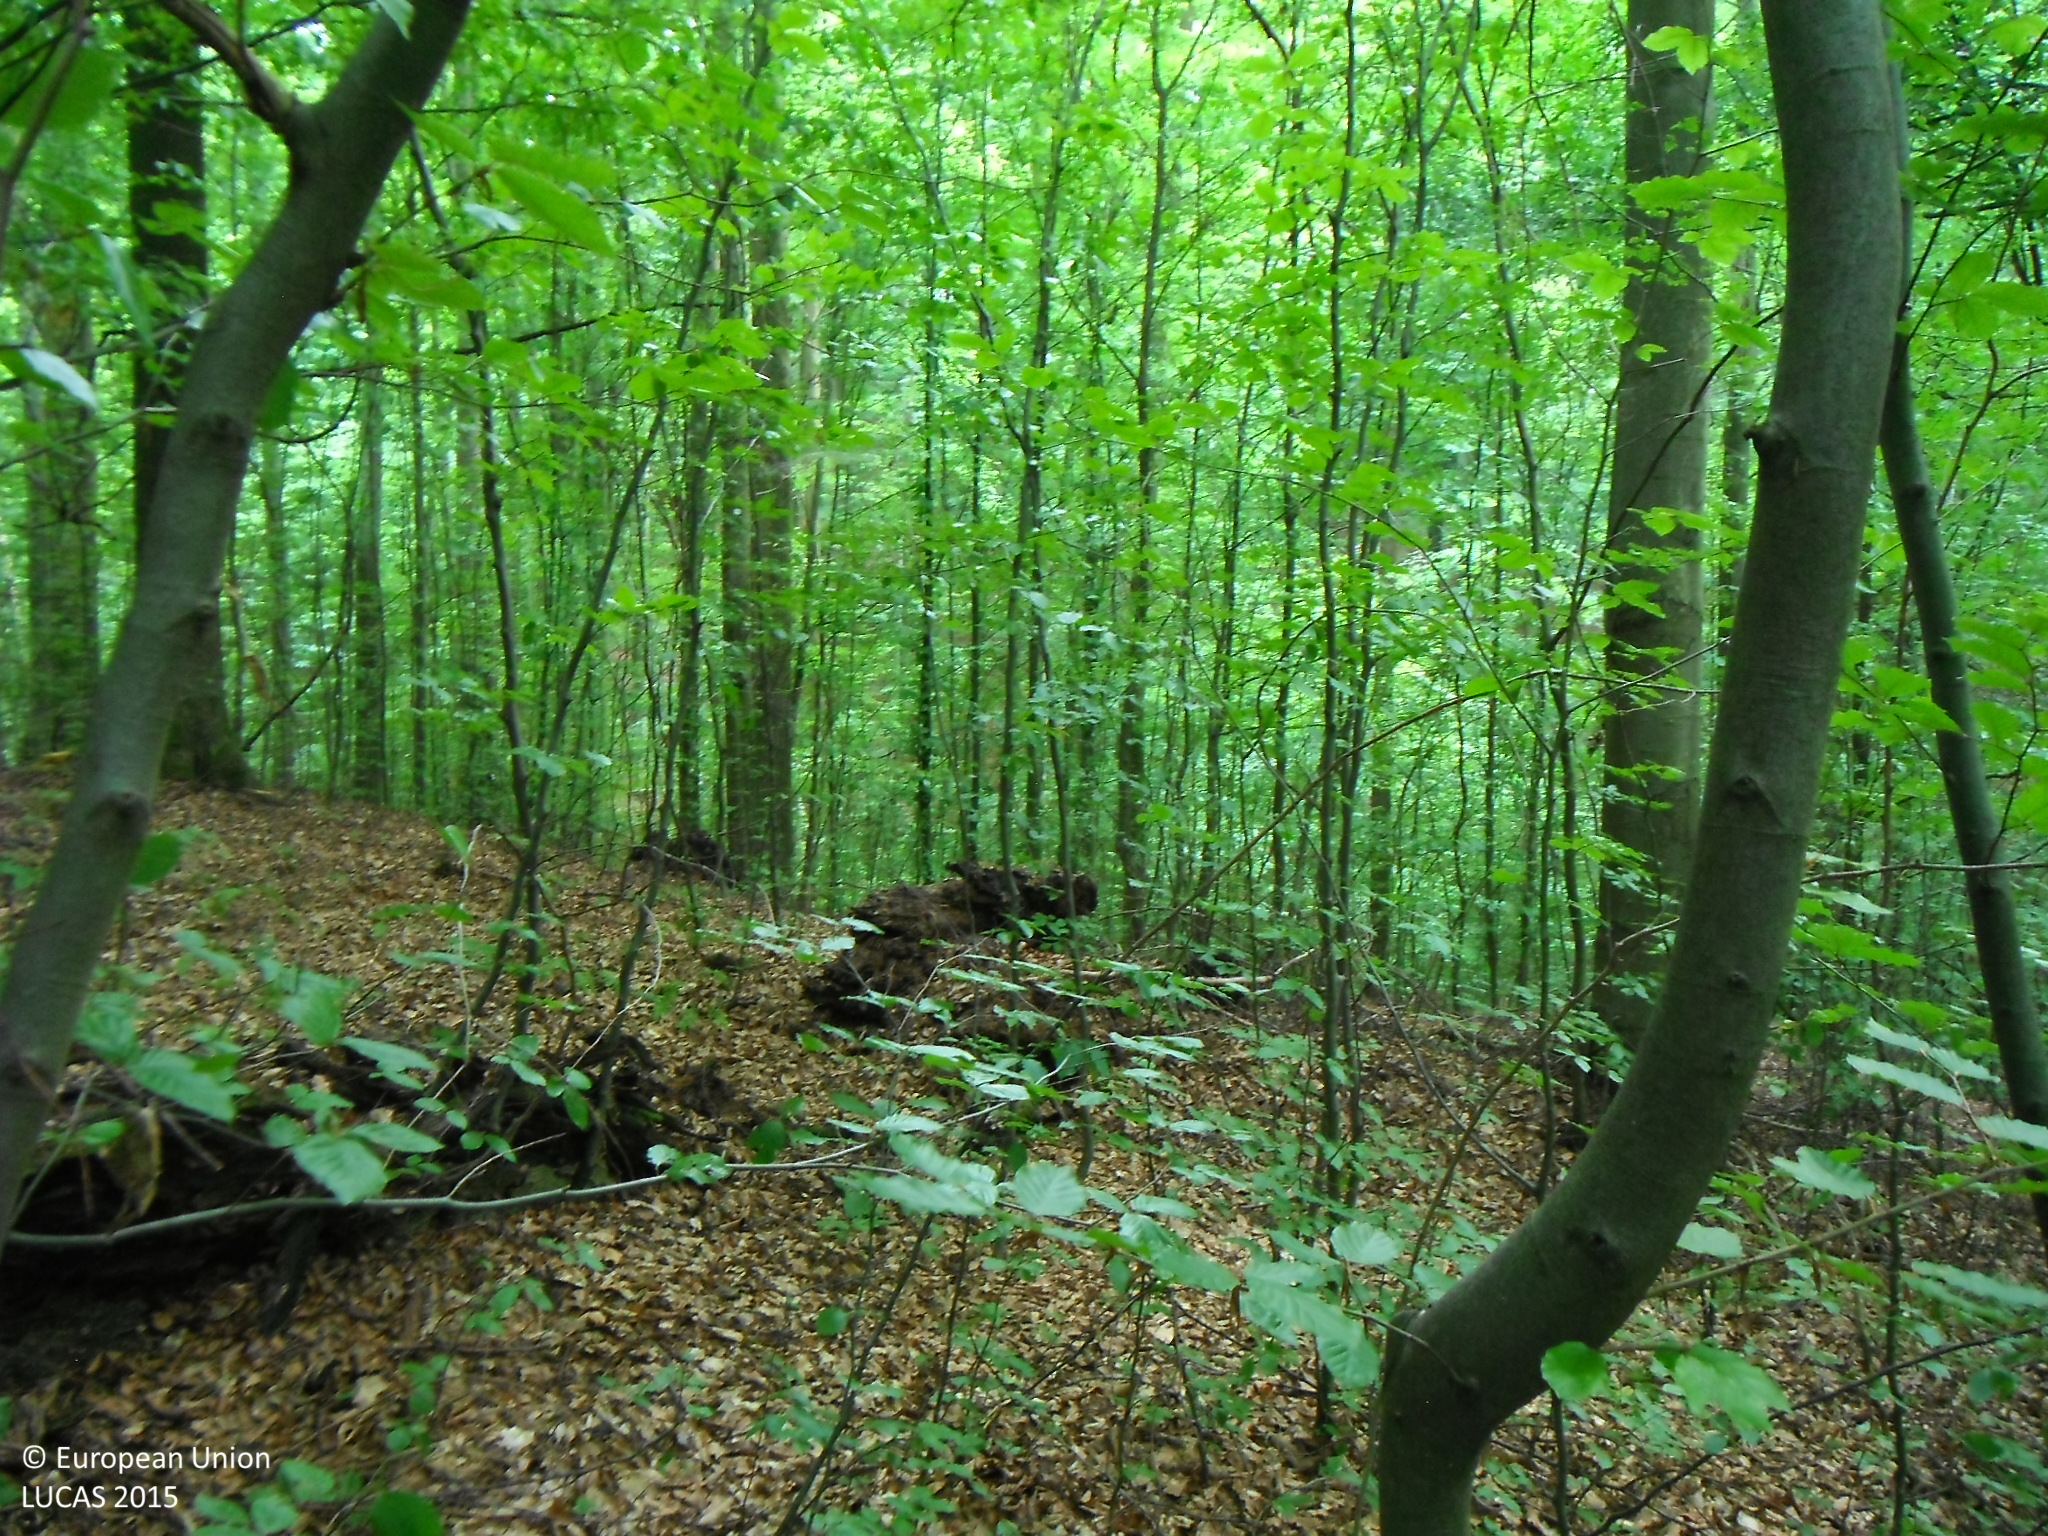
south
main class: Woodland
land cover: Broadleaved woodland
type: beech forest
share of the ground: > 75 %
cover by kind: broadleaved forest trees 100 %
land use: Forestry
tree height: > 5 m
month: July
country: SK
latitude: 49.3124
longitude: 21.6468
